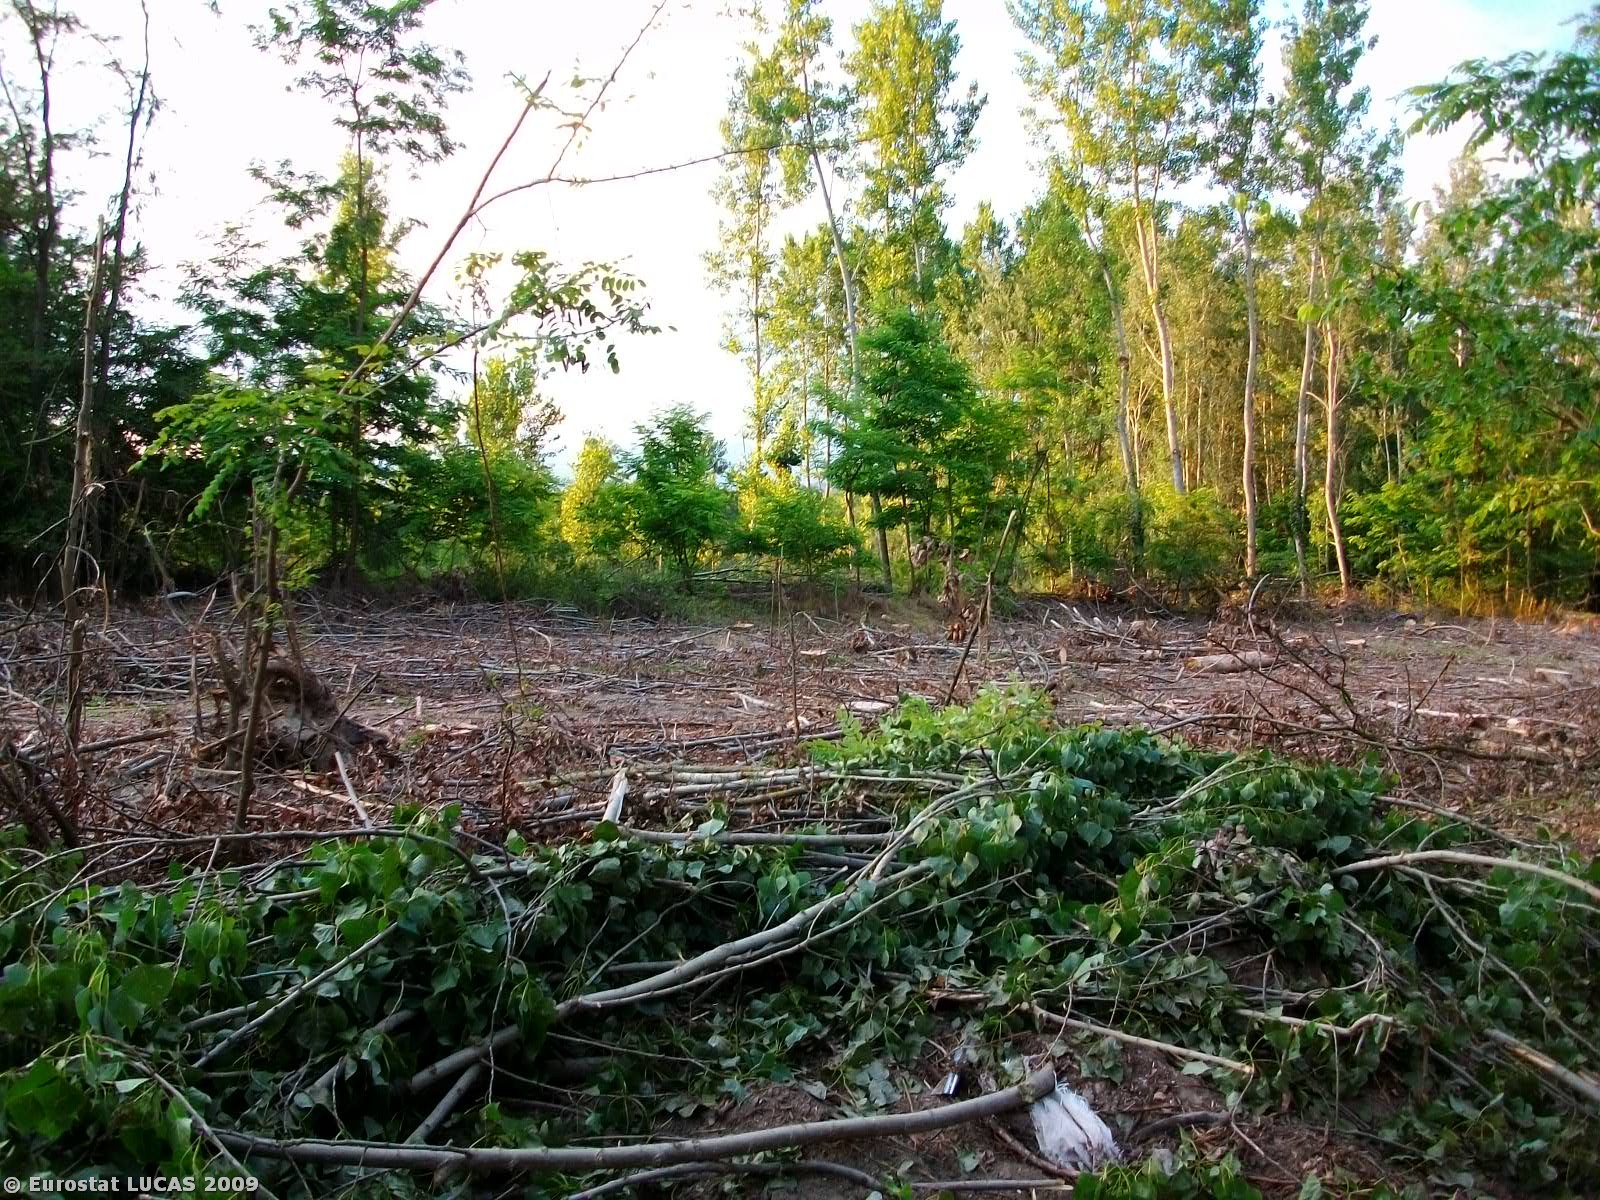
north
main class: Woodland
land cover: Broadleaved woodland
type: non-riverine alder, birch or aspen forest
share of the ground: > 75 %
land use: Forestry
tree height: > 5 m
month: June
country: GR
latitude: 41.0765
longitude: 23.5770
